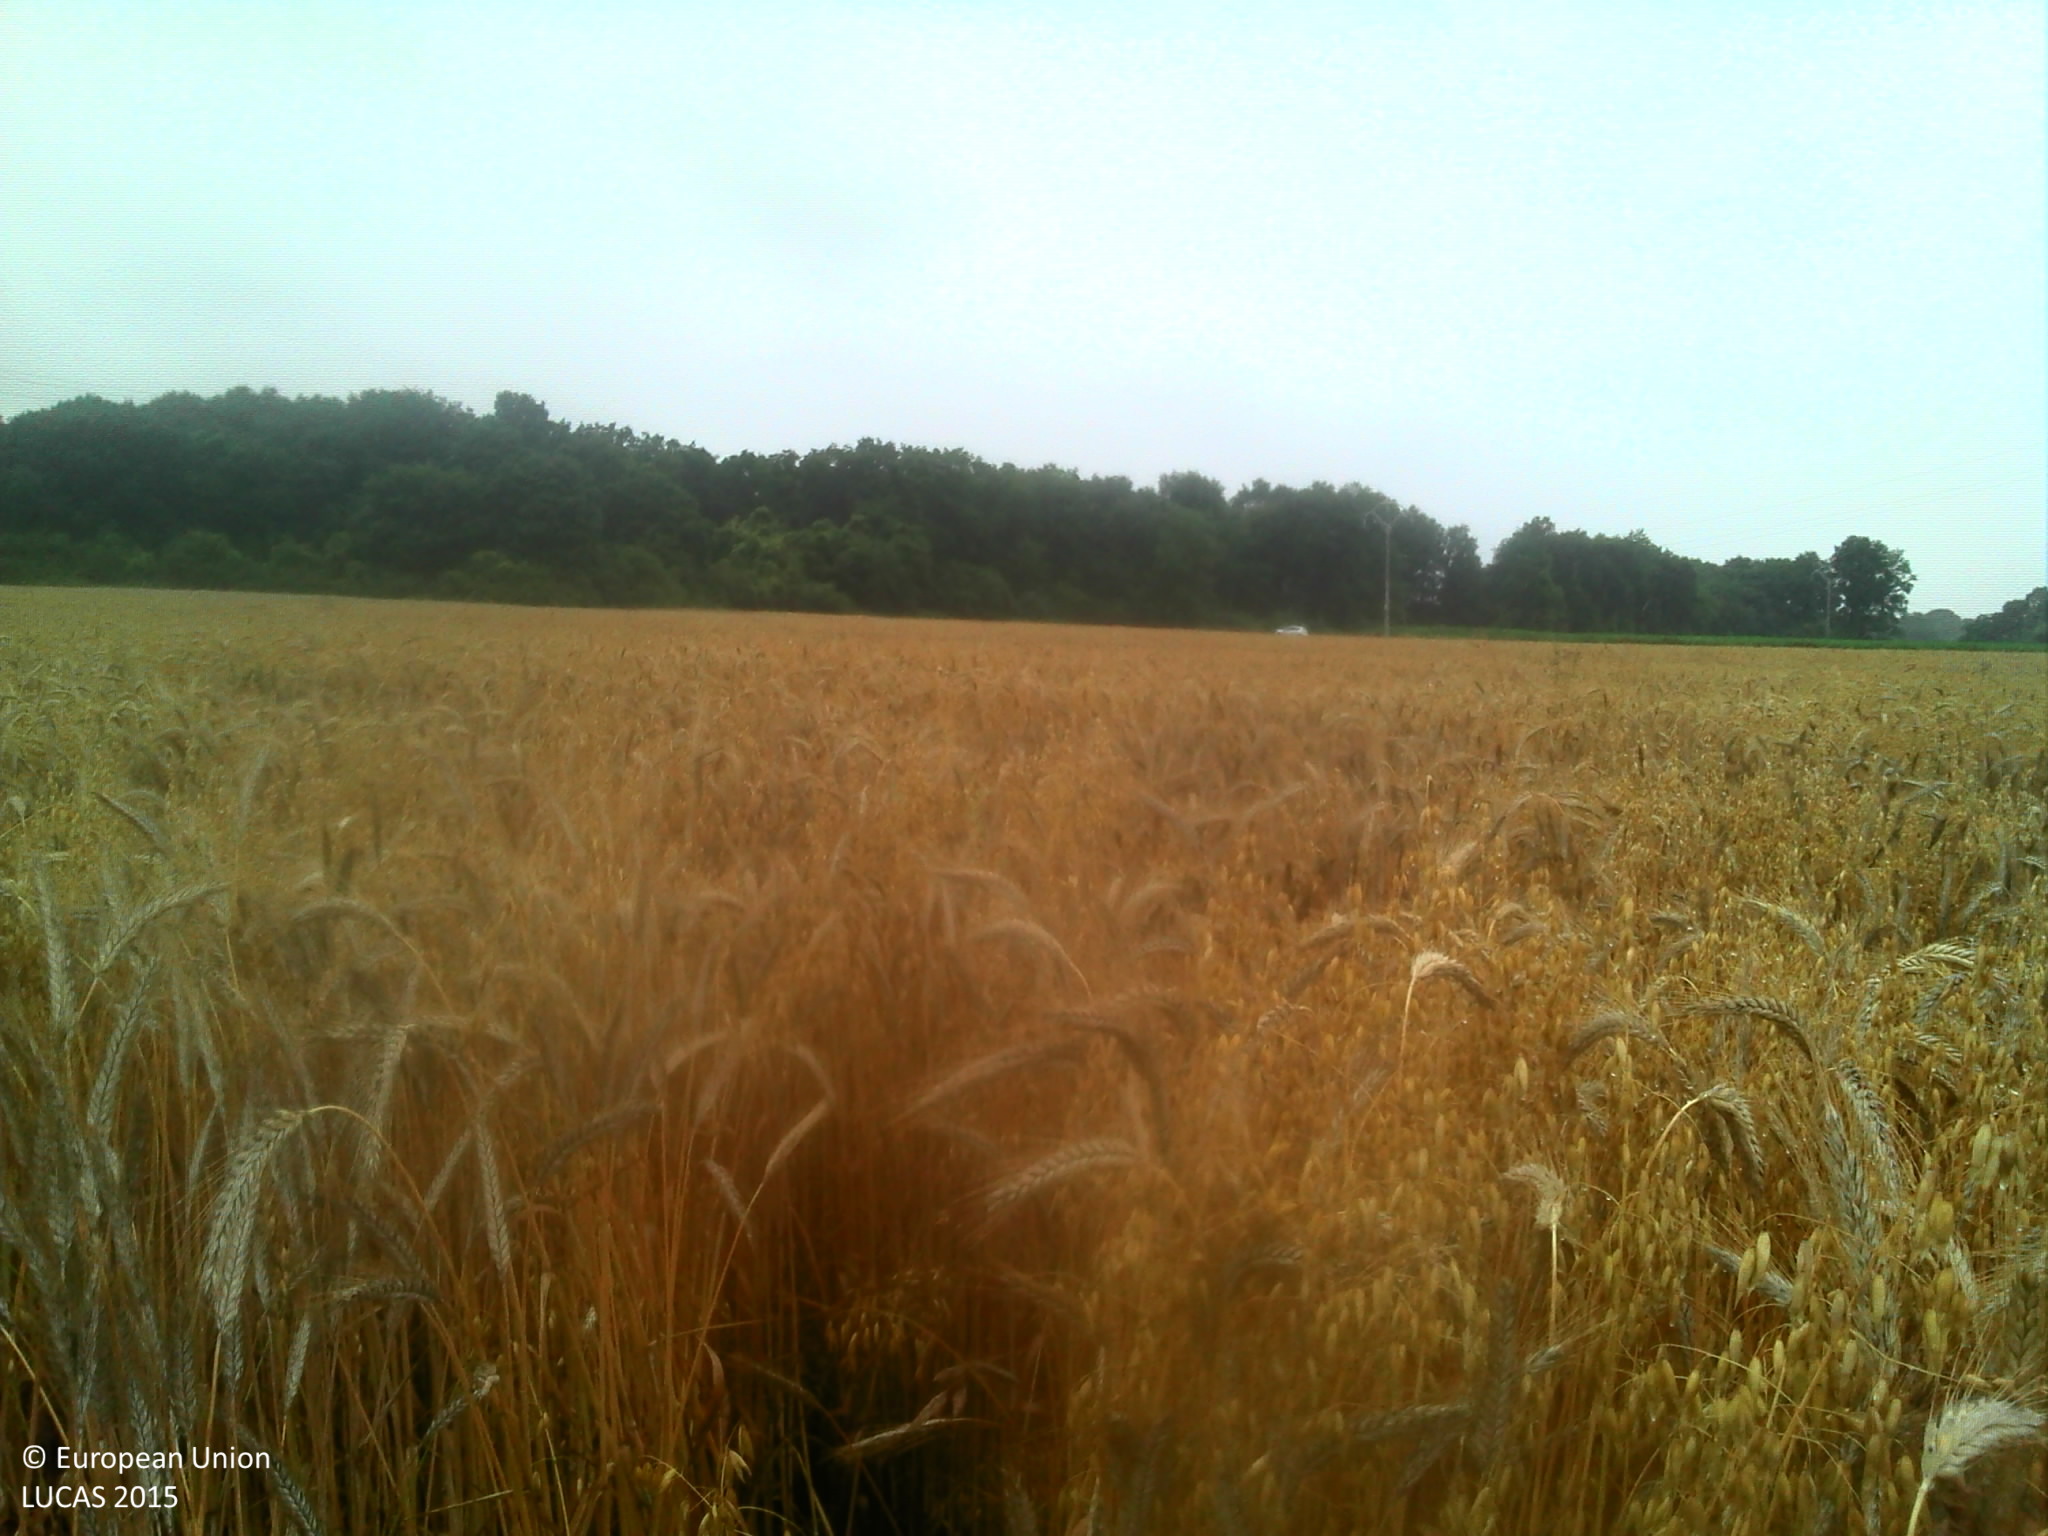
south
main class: Cropland
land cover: Mixed cereals for fodder
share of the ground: > 75 %
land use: Agriculture (excluding fallow land and kitchen gardens)
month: July
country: BE
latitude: 50.1713
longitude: 4.7462
